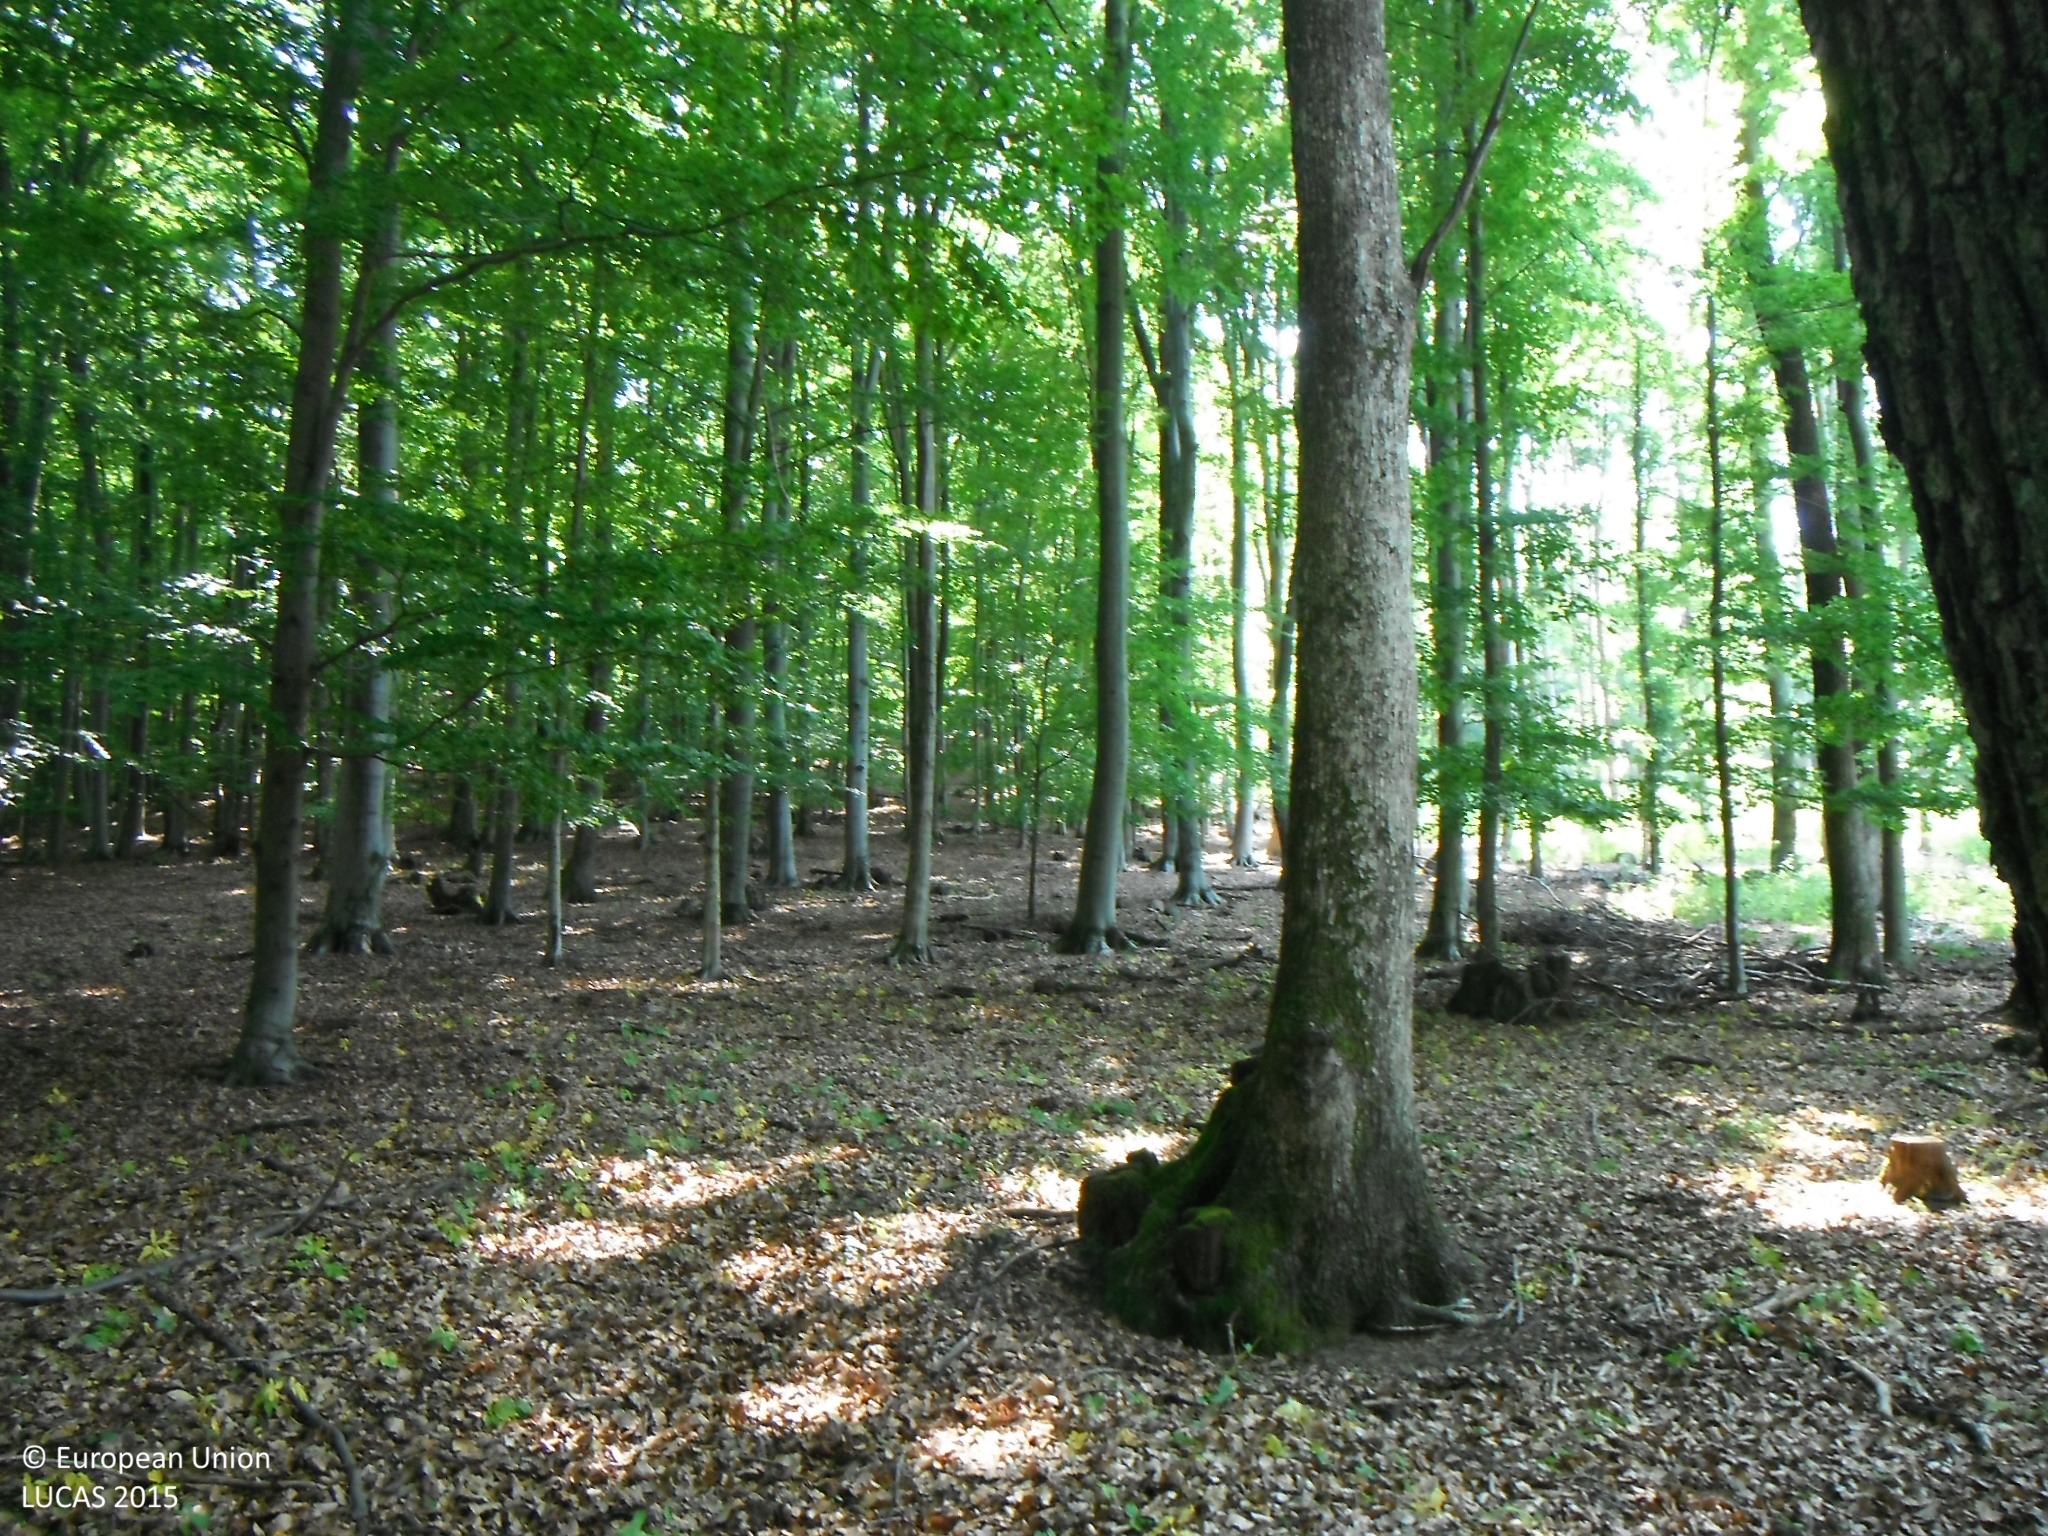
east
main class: Woodland
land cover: Broadleaved woodland
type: mesophytic deciduous forest
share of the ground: > 75 %
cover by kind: broadleaved forest trees 100 %
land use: Forestry
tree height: > 5 m
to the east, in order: Broadleaved woodland
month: July
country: SK
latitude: 48.2328
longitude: 19.2441
